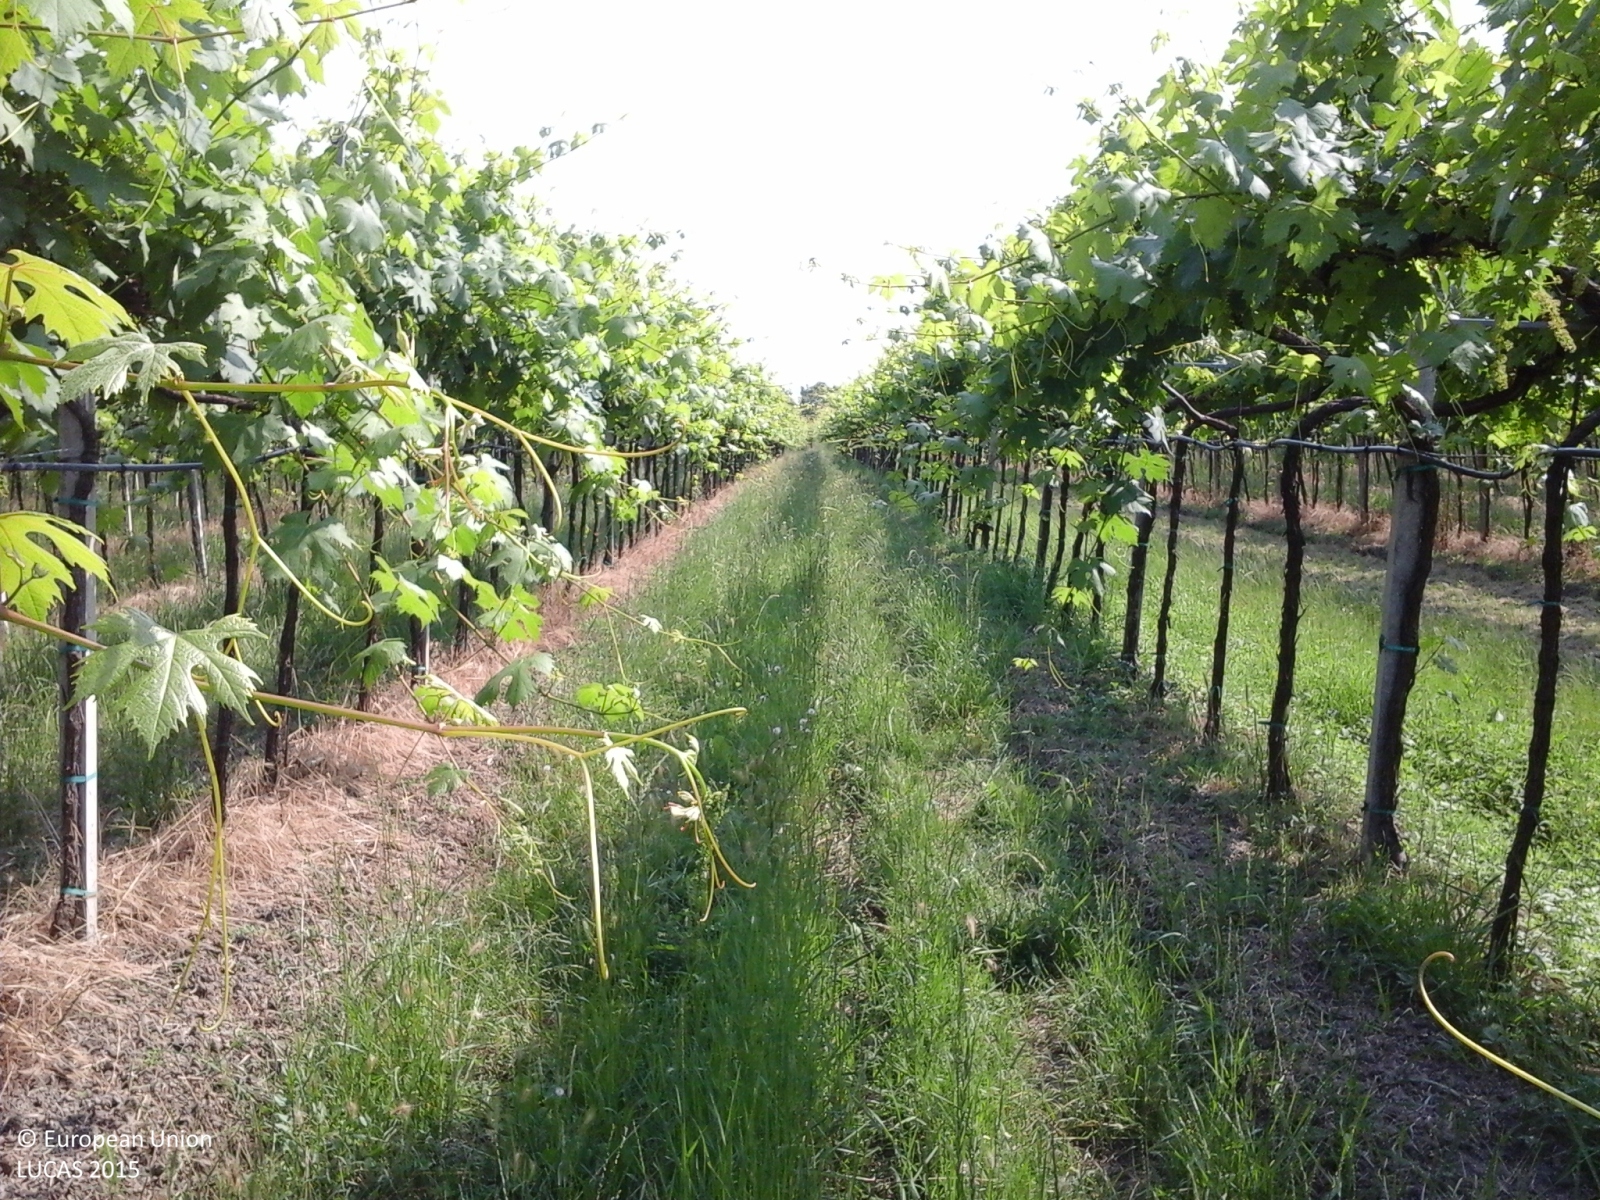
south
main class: Cropland
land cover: Vineyards
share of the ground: 25 - 50 %
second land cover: Grassland without tree/shrub cover
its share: 50 - 75 %
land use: Agriculture (excluding fallow land and kitchen gardens)
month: May
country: IT
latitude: 44.7448
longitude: 10.7184
